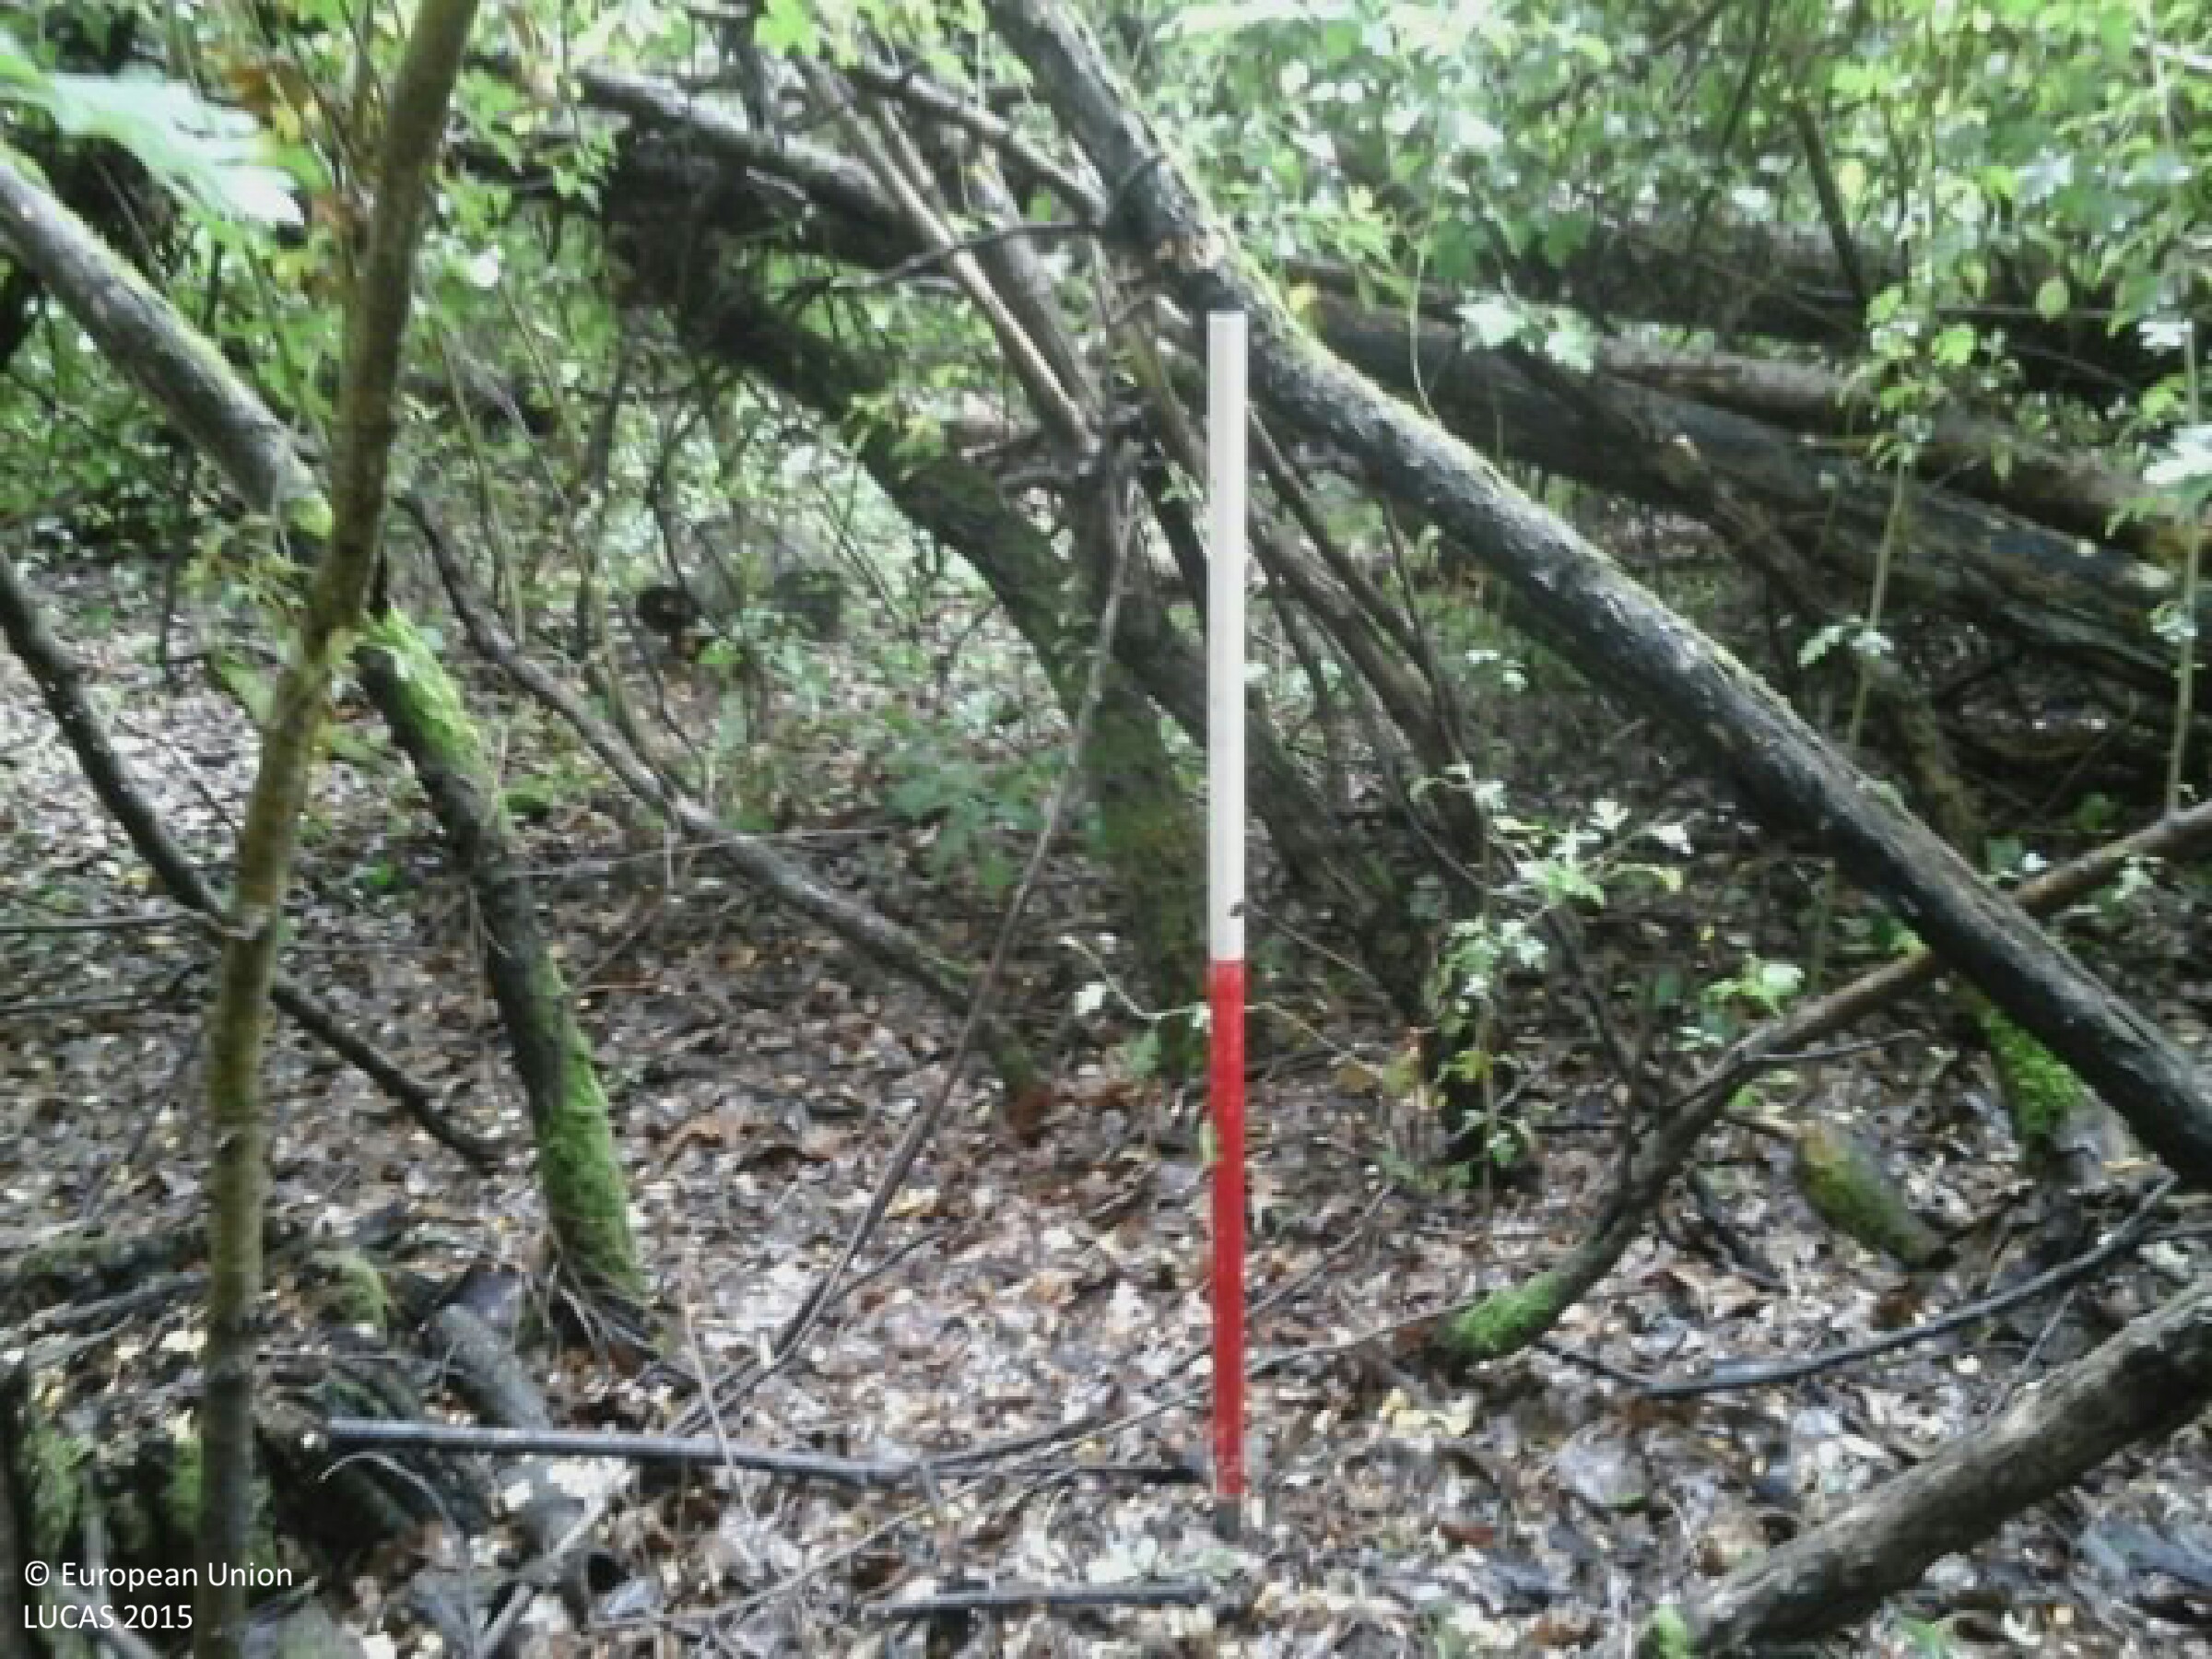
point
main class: Woodland
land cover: Broadleaved woodland
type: thermophilous deciduous forest
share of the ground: > 75 %
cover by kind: broadleaved forest trees 70 %, shrubs 20 %, coniferous forest trees 5 %, herbaceous plants 5 %
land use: Forestry
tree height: > 5 m
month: July
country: HU
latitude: 46.4188
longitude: 18.8467
